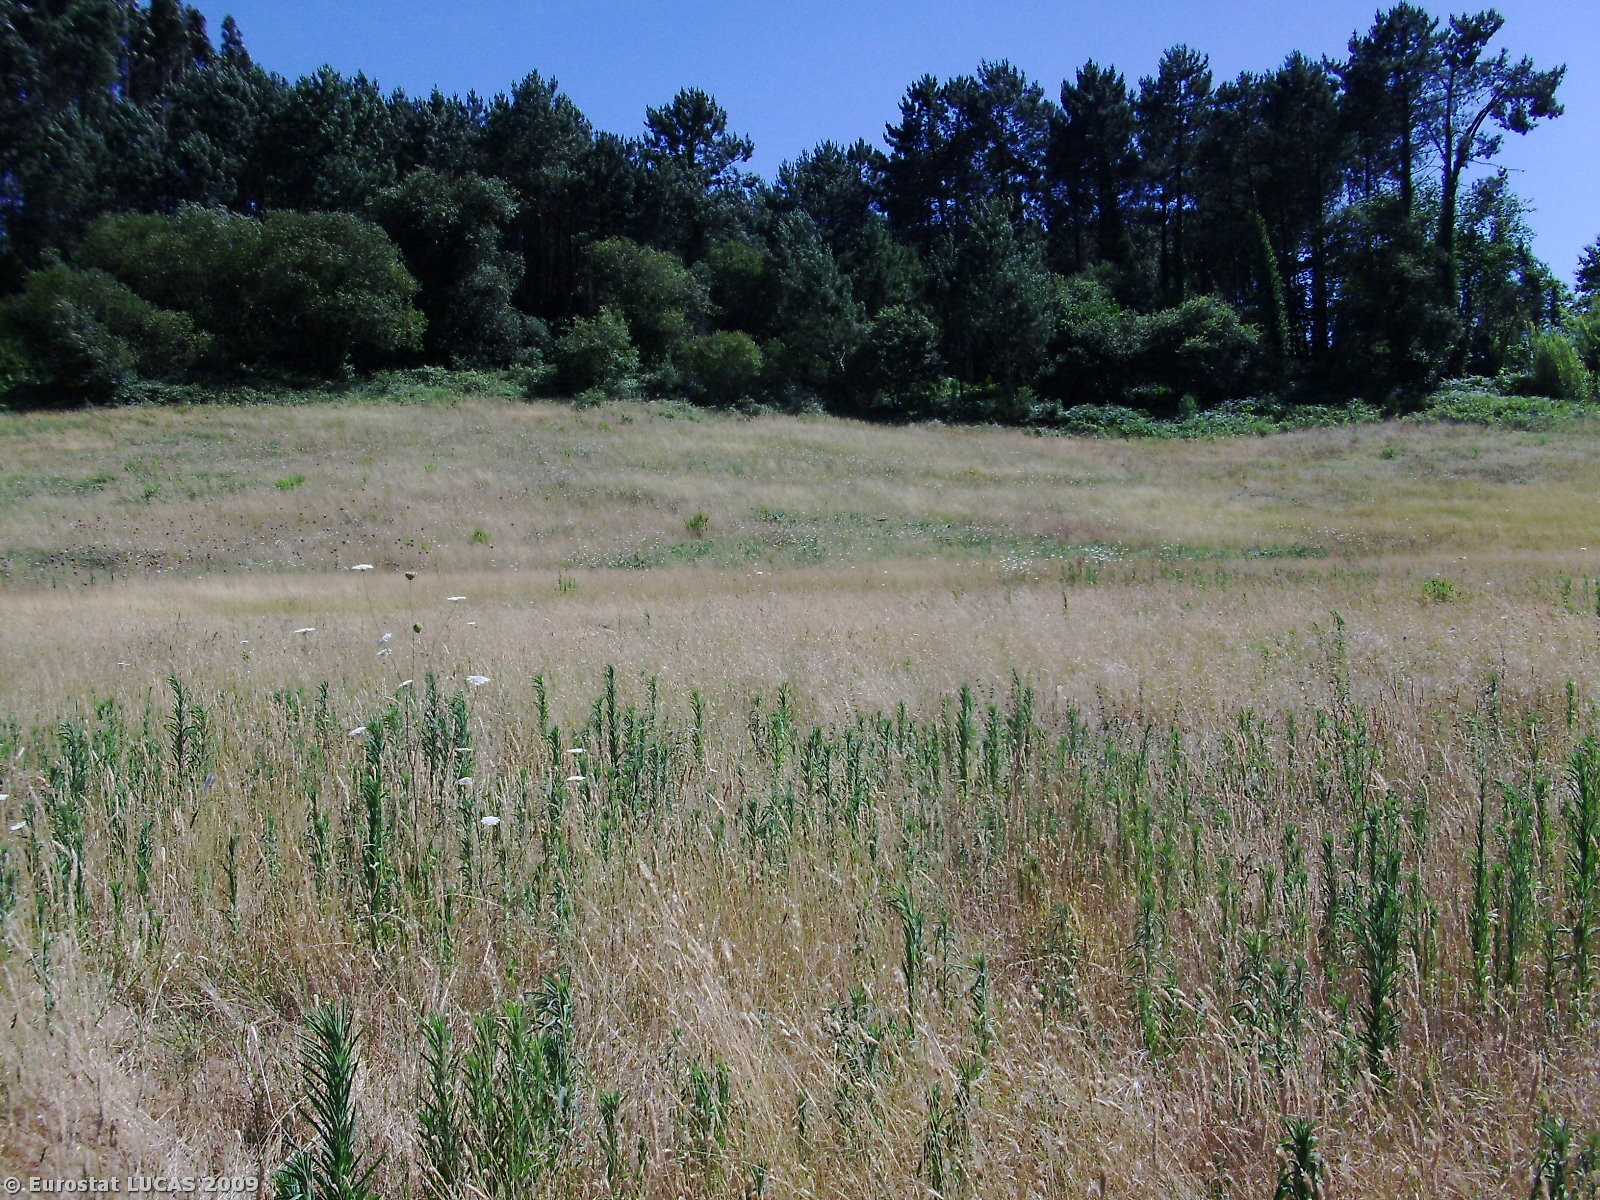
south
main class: Grassland
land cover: Spontaneously vegetated surfaces
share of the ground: > 75 %
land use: Fallow land
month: July
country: PT
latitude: 39.6769
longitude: -8.8683
